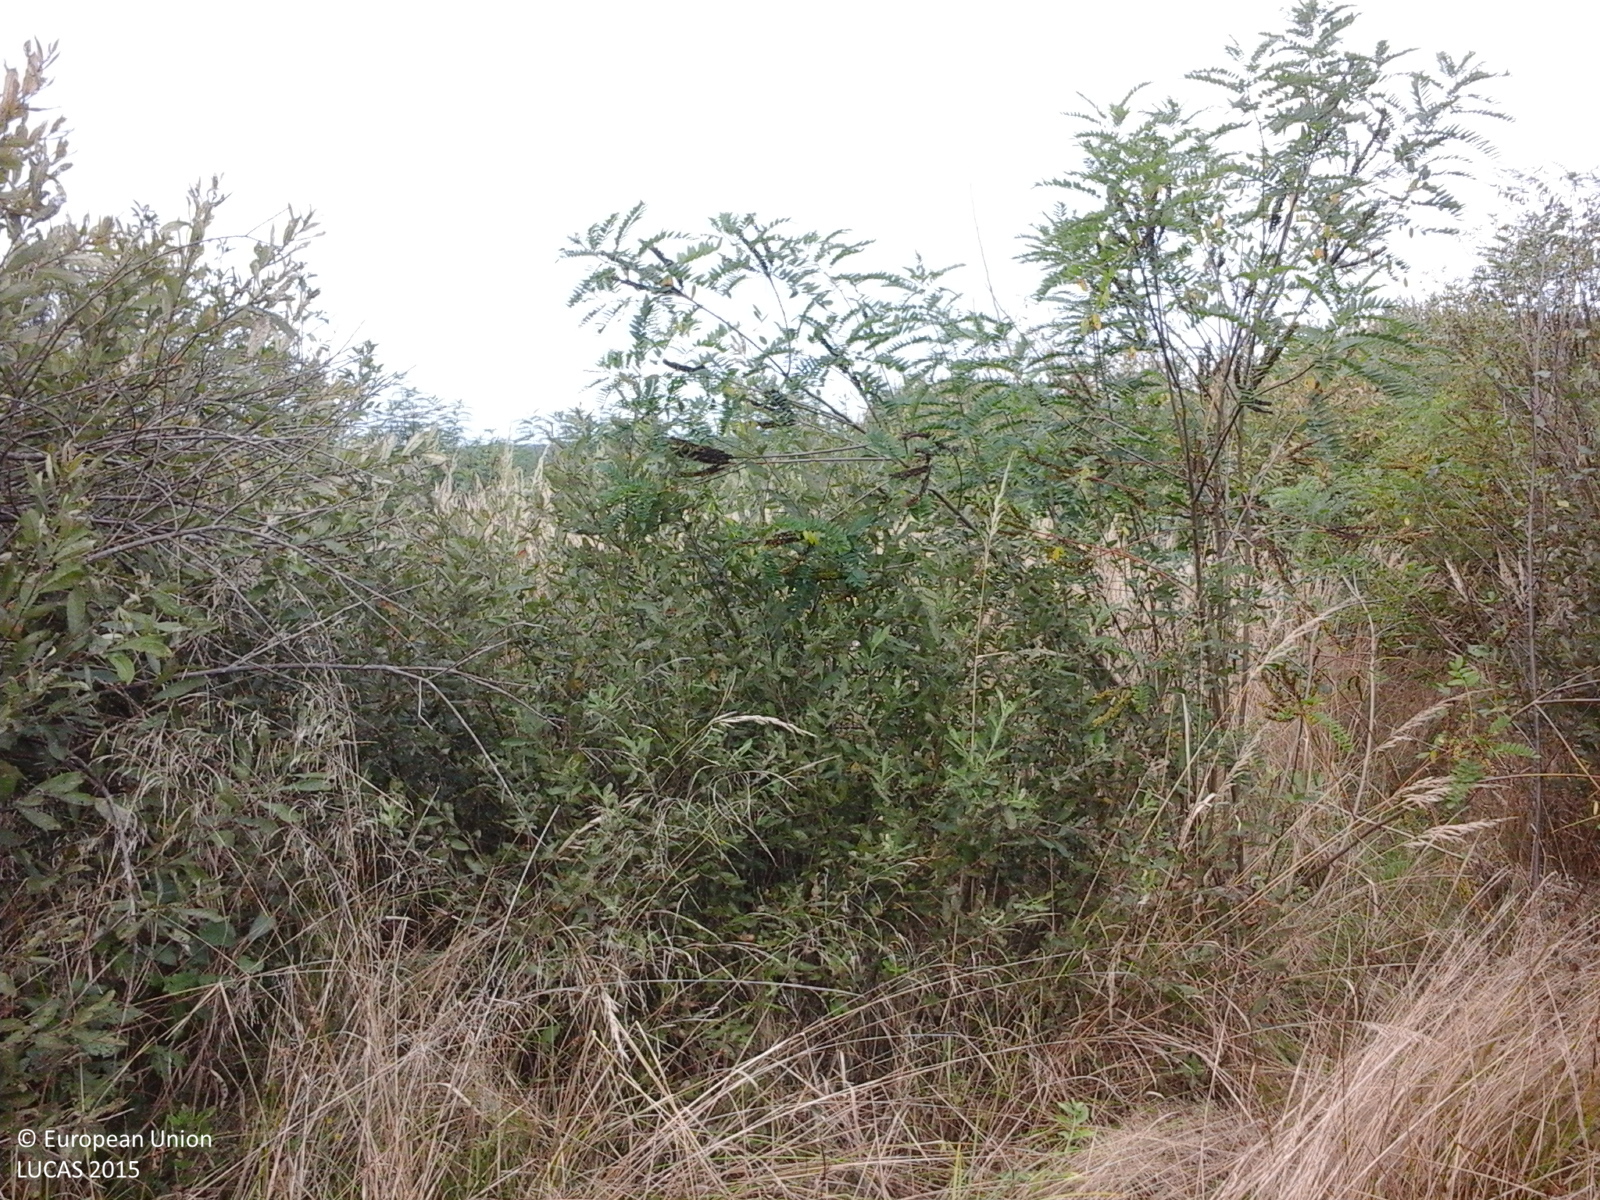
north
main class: Shrubland
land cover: Shrubland without tree cover
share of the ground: > 75 %
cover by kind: shrubs 100 %
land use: Semi-natural and natural areas not in use
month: September
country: RO
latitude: 45.9788
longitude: 22.1899
